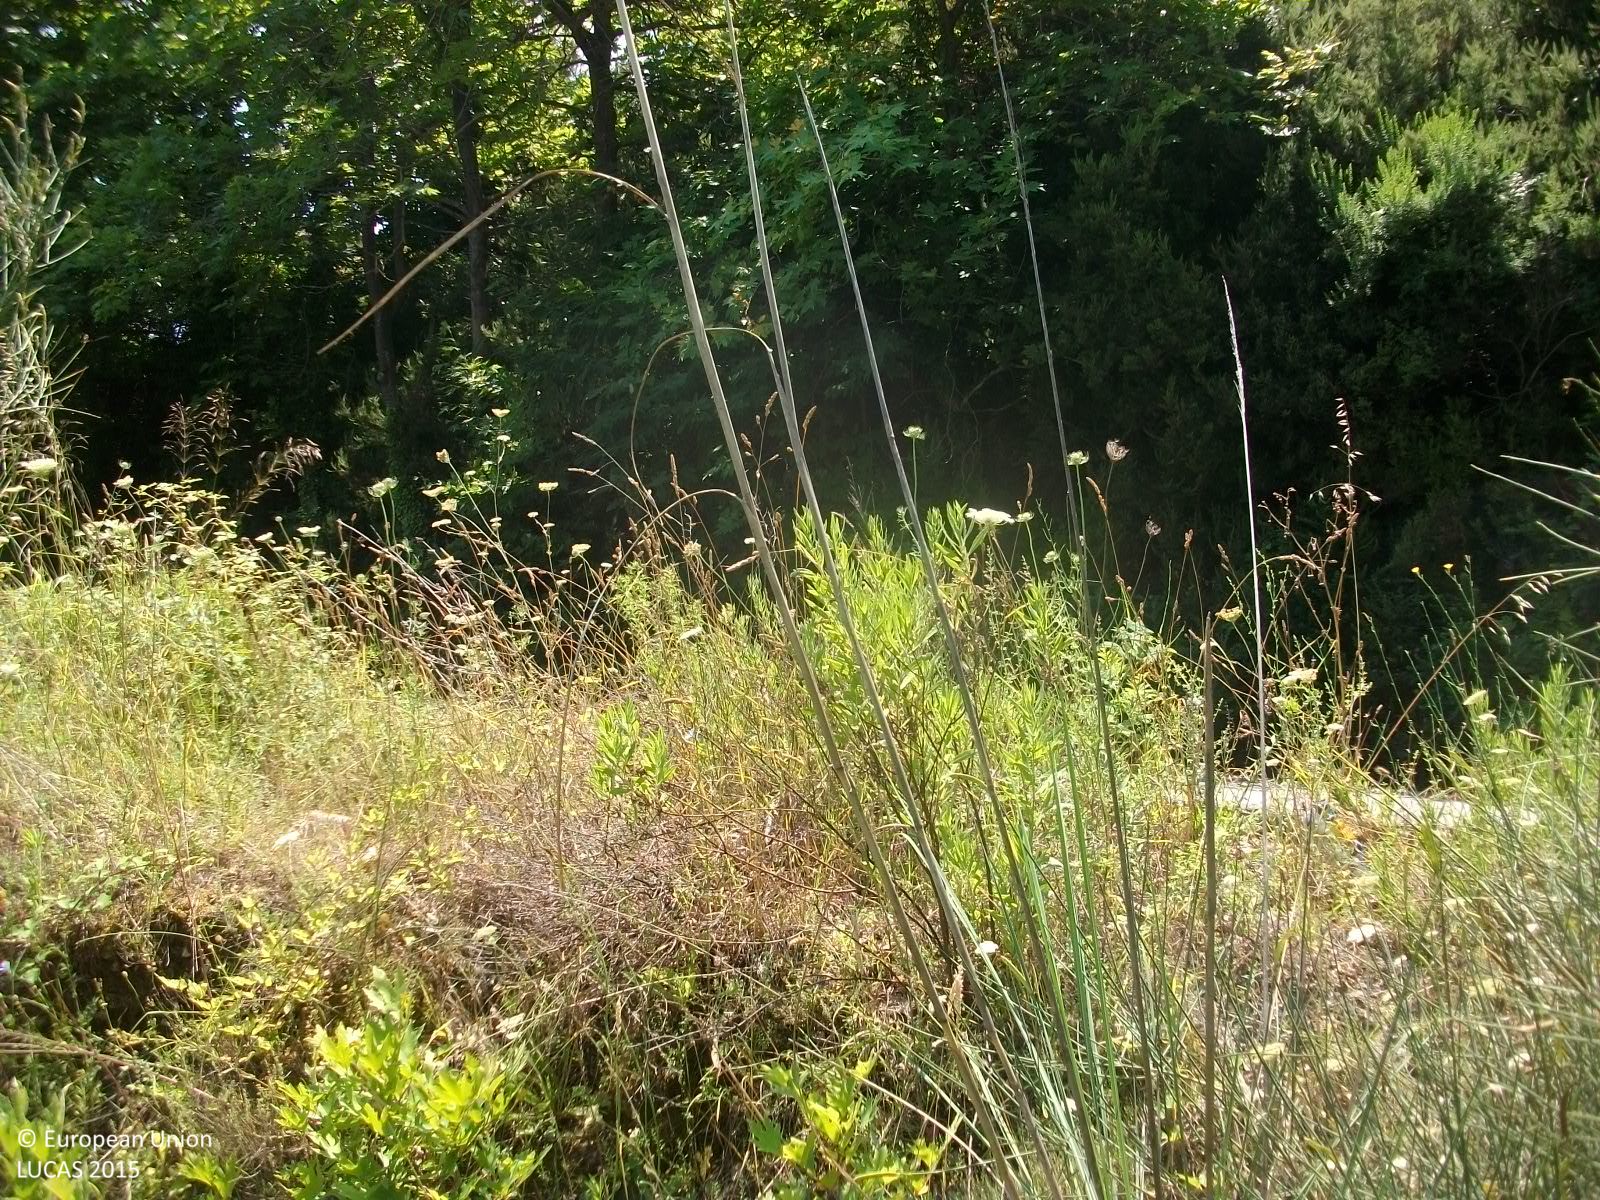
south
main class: Woodland
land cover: Broadleaved woodland
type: thermophilous deciduous forest
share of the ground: > 75 %
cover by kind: broadleaved forest trees 90 %, herbaceous plants 10 %
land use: Forestry
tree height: > 5 m
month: July
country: GR
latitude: 39.4141
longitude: 23.1538
